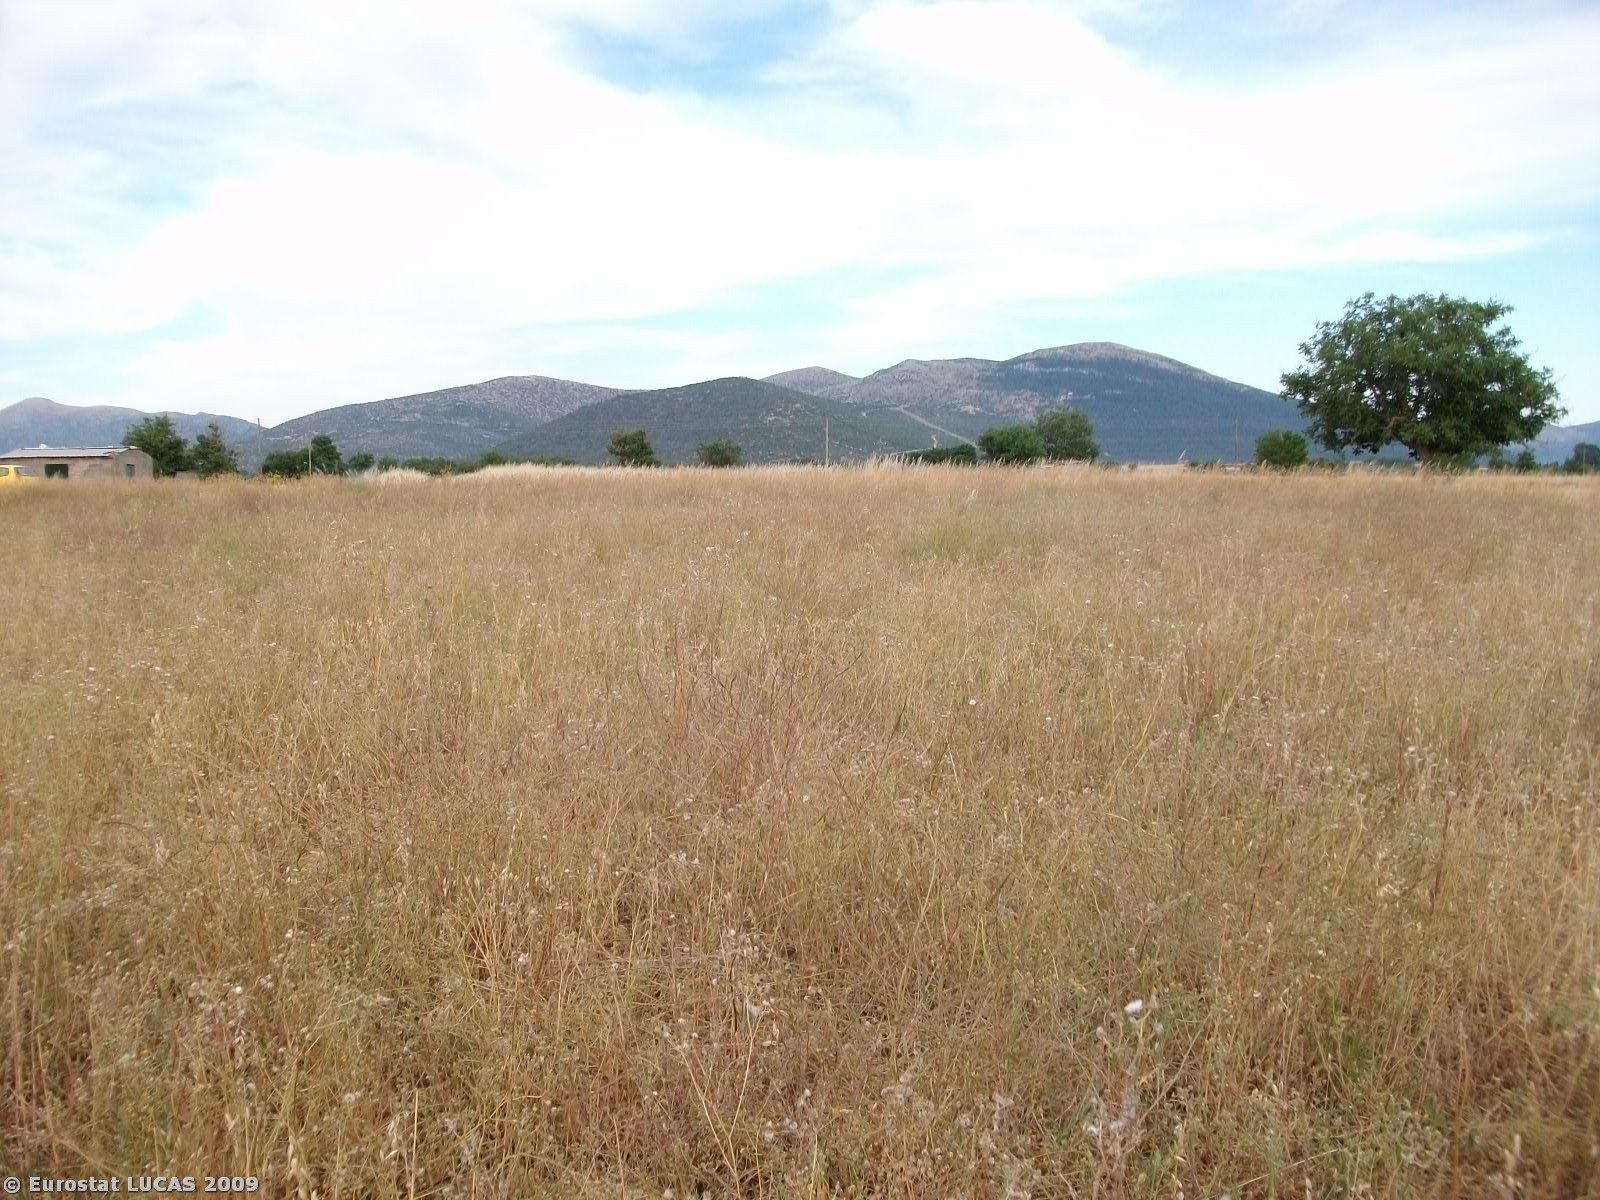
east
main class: Grassland
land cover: Spontaneously vegetated surfaces
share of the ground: > 75 %
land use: Fallow land
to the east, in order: Spontaneously vegetated surfaces; Paved roads, cycling and walking lanes; Electric lines; Common wheat; Grass margins; Tracks; Potatoes
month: June
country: GR
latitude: 37.4778
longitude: 22.4347
